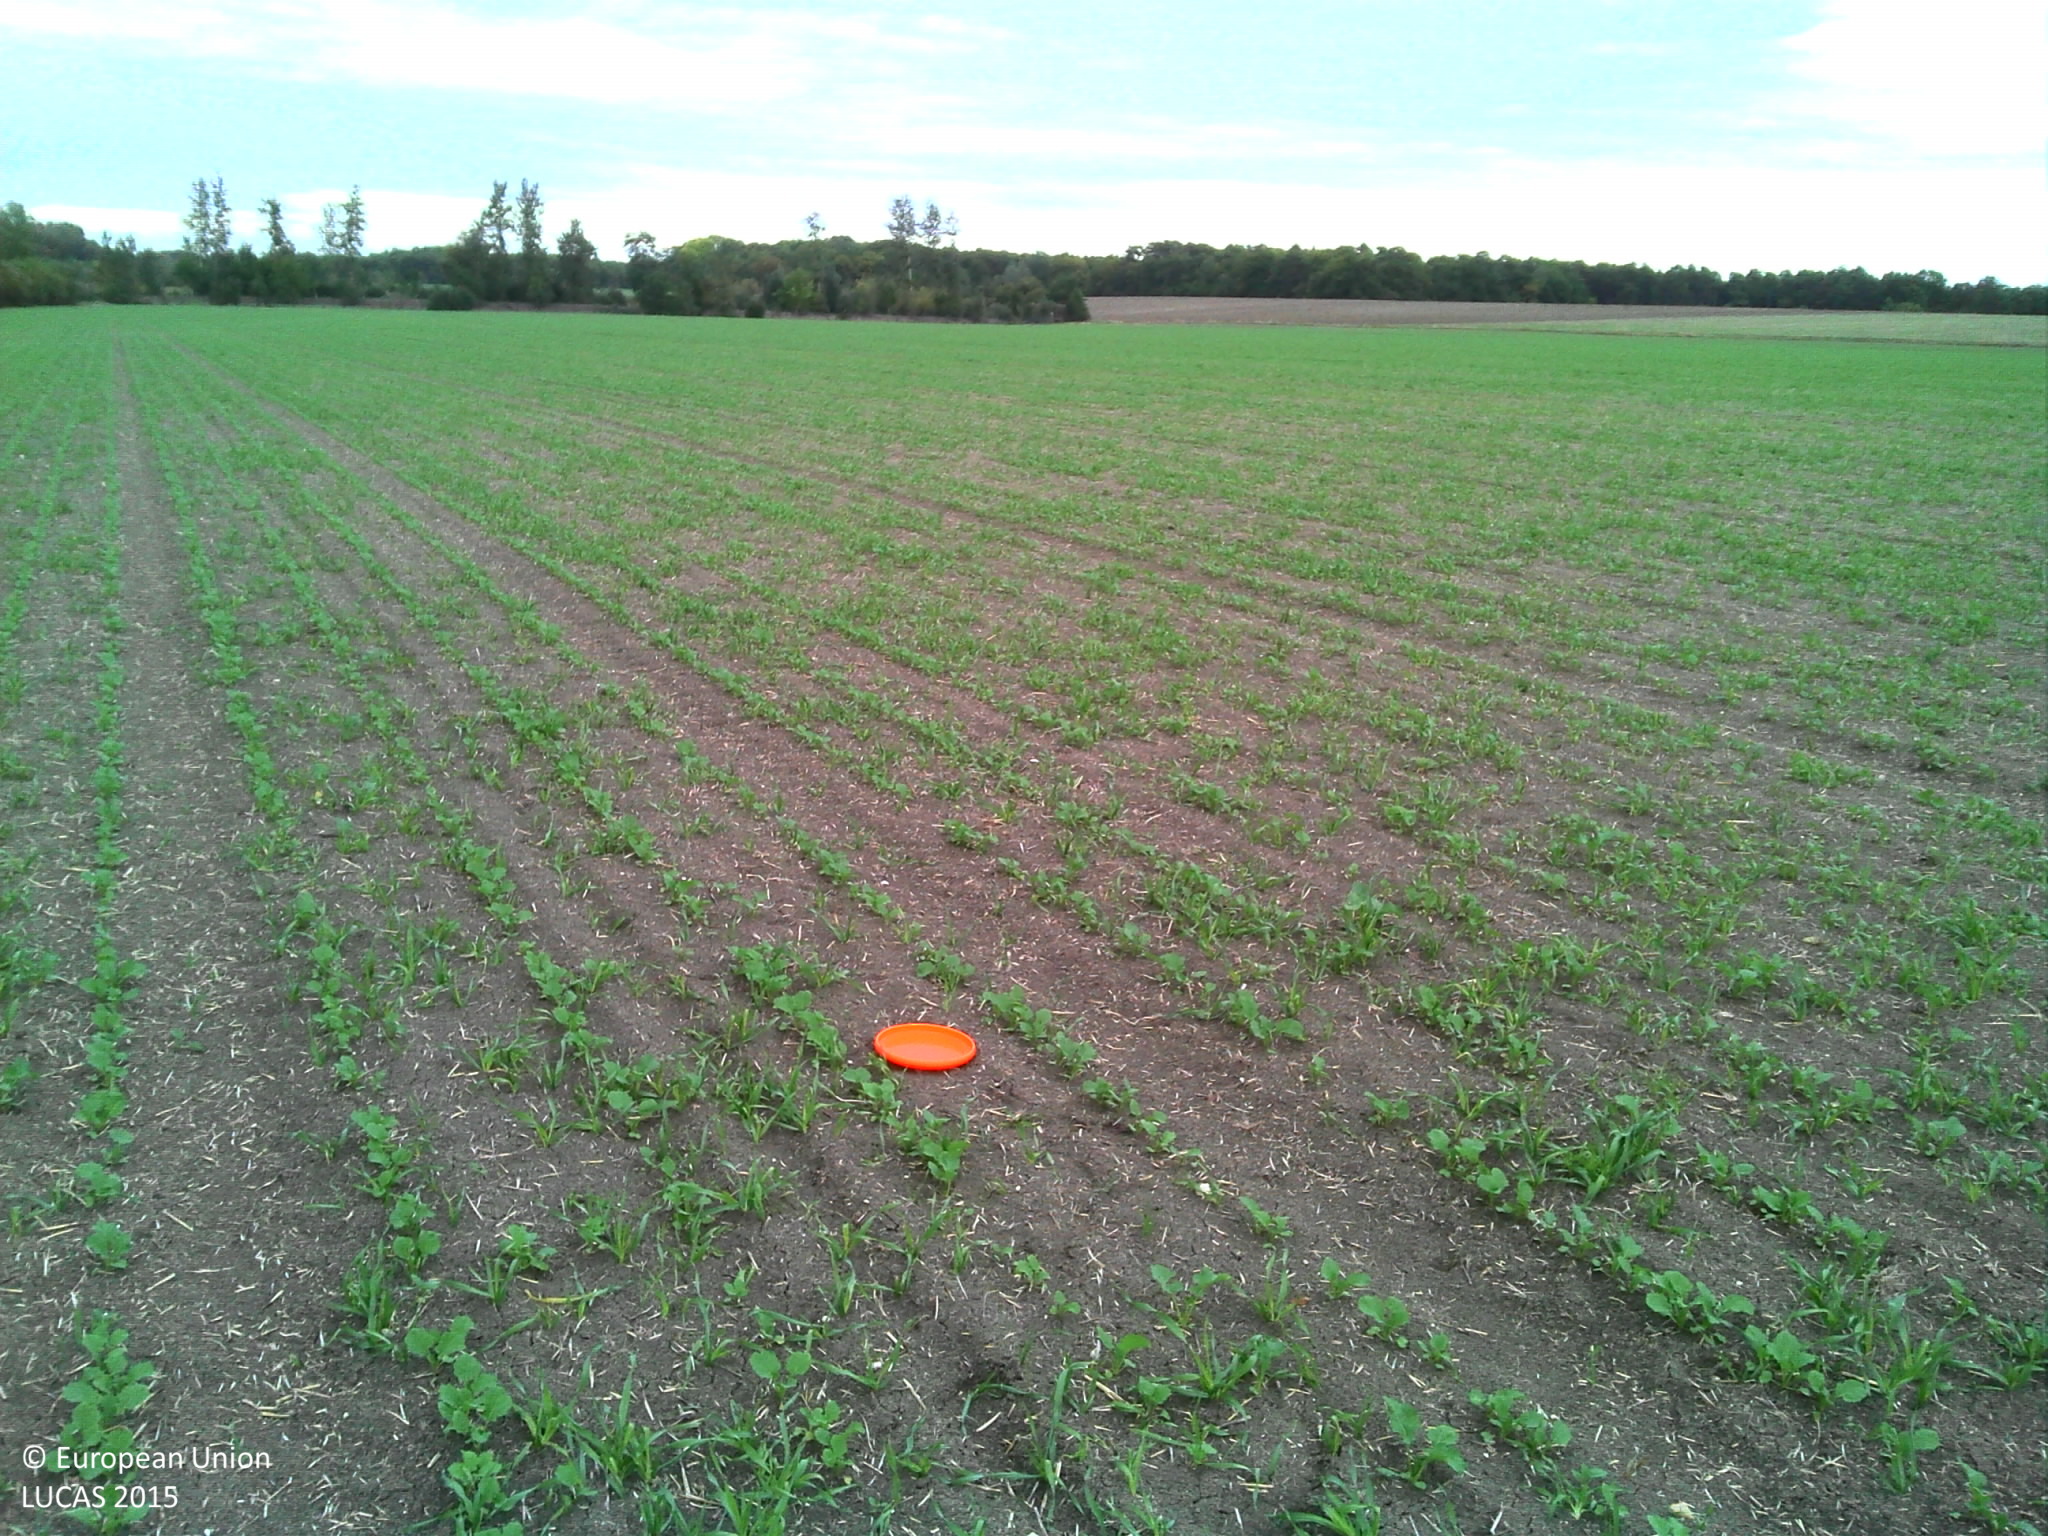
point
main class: Cropland
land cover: Rape and turnip rape
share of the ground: 50 - 75 %
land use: Agriculture (excluding fallow land and kitchen gardens)
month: September
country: FR
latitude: 48.3268
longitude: 4.2645
